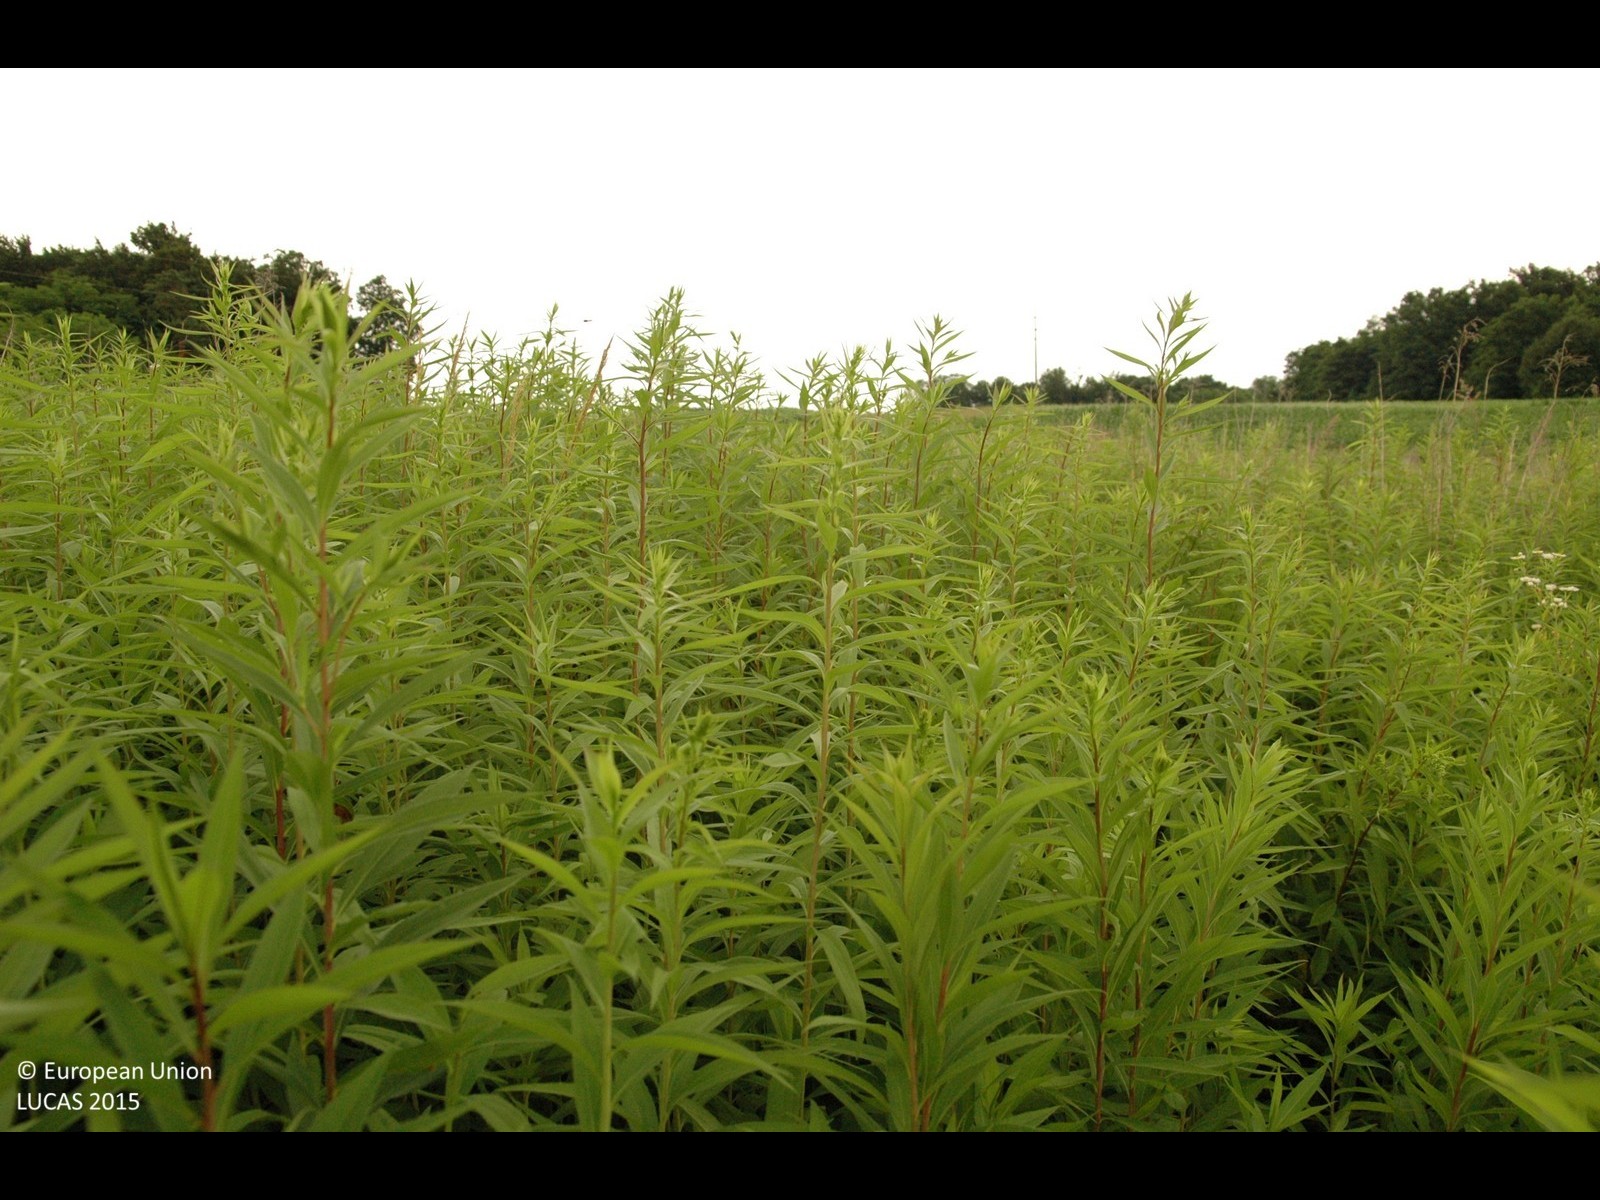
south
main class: Grassland
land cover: Spontaneously vegetated surfaces
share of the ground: > 75 %
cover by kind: herbaceous plants 95 %, shrubs 5 %
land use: Agriculture (excluding fallow land and kitchen gardens)
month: June
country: HR
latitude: 46.4162
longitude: 16.3364
